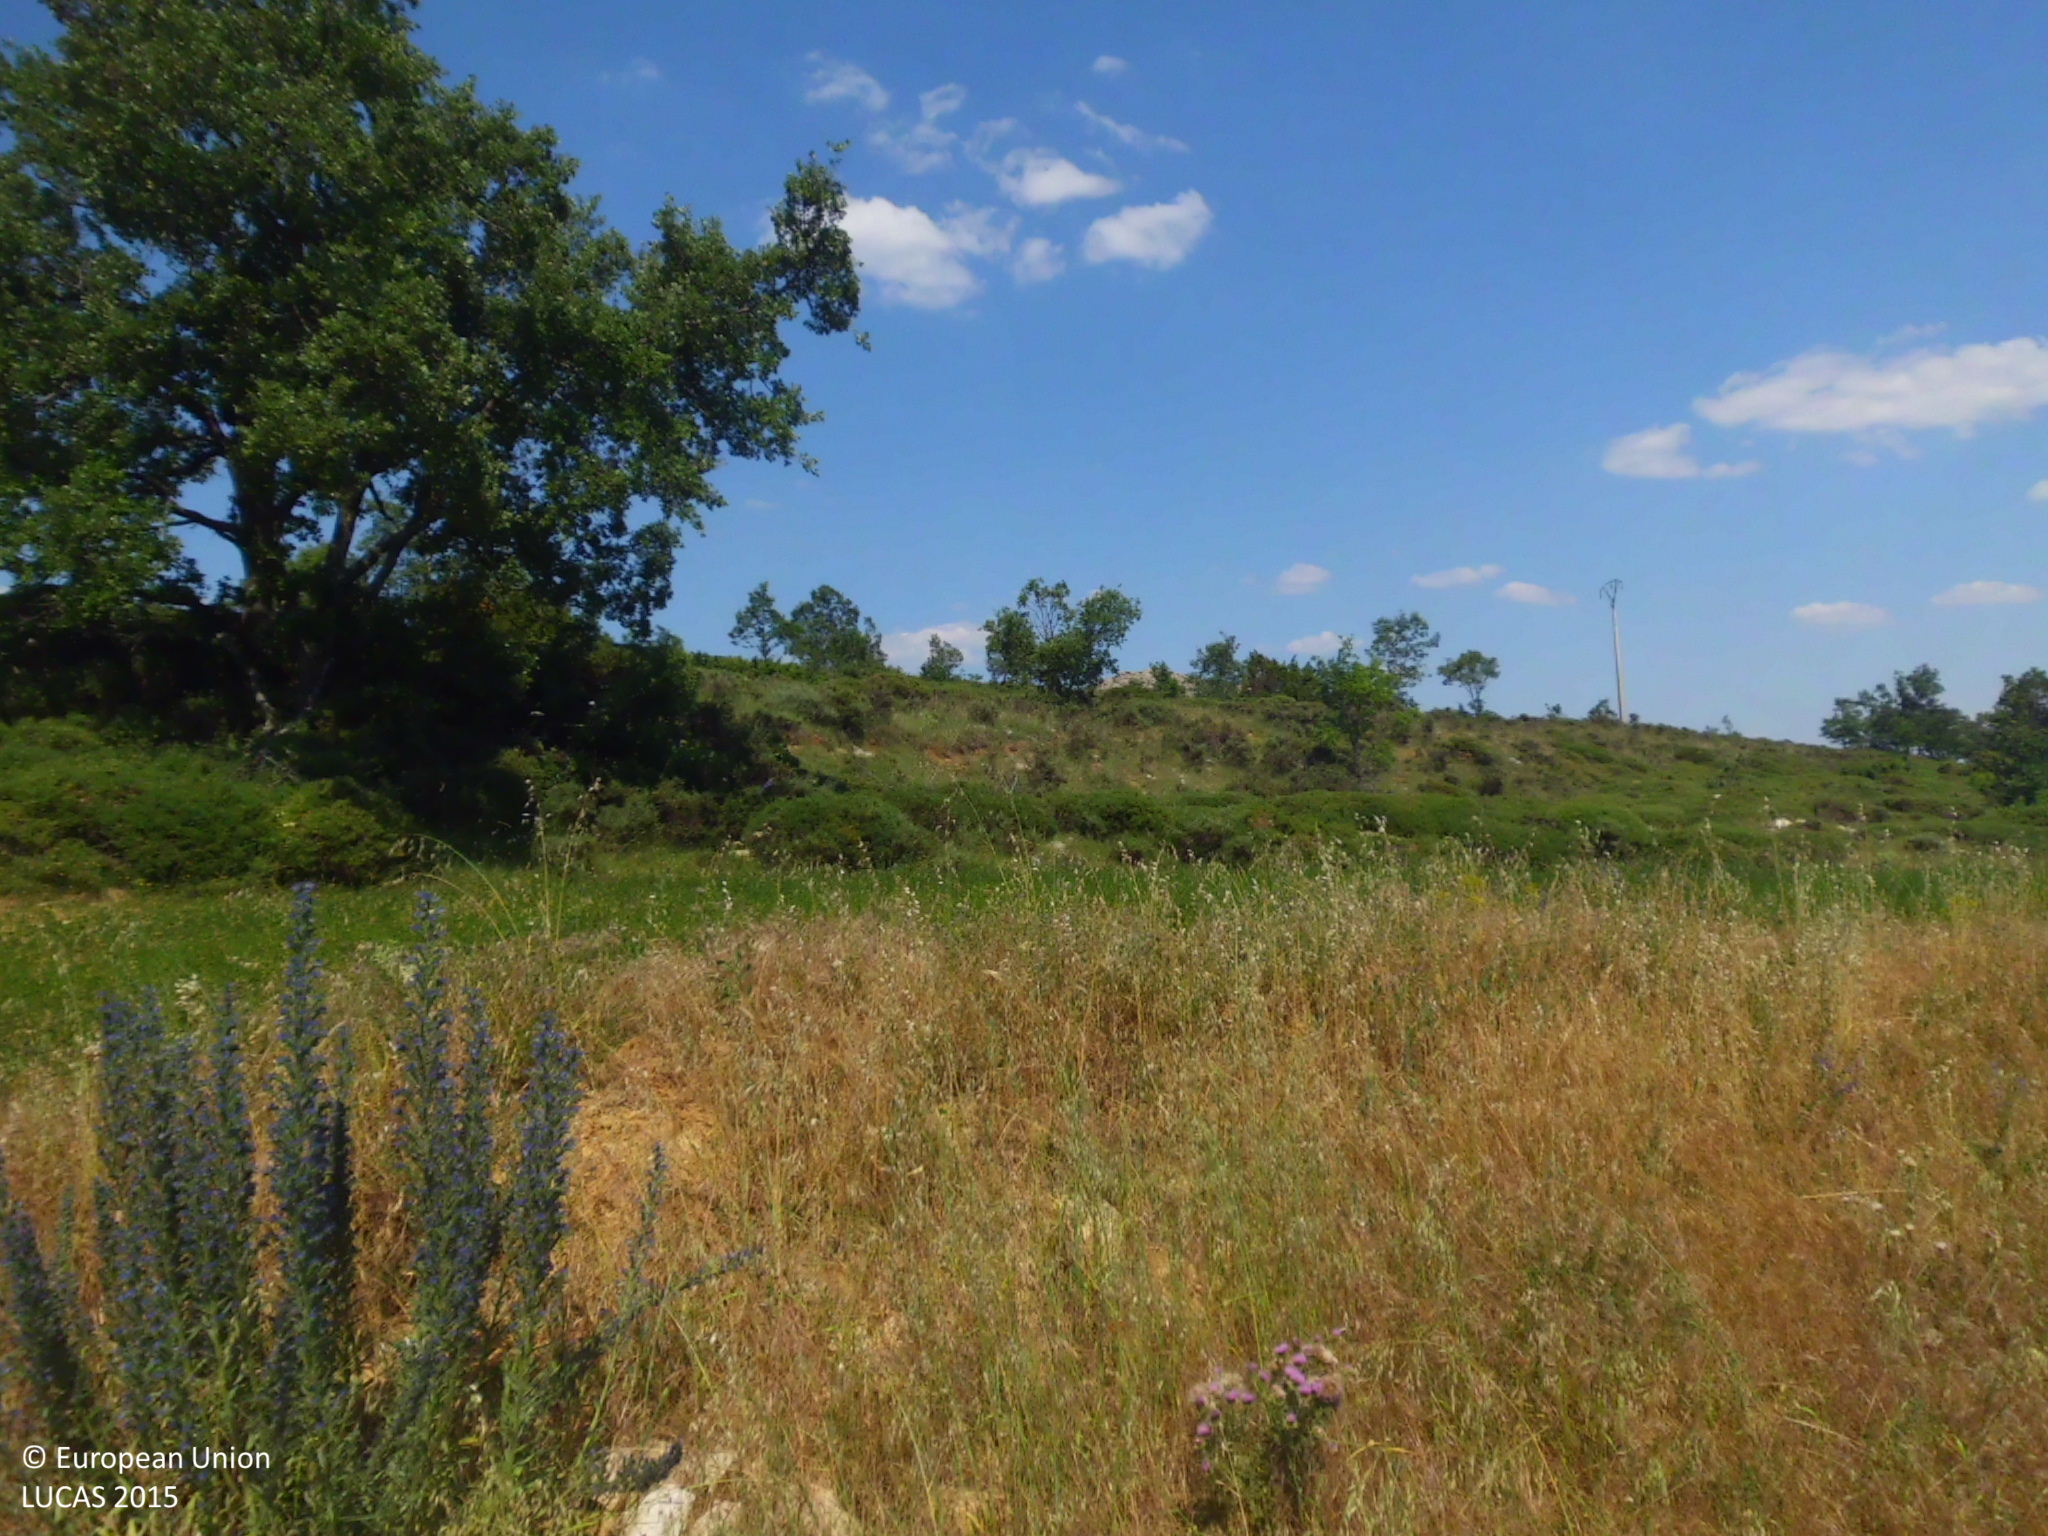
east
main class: Cropland
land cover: Lucerne
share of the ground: 50 - 75 %
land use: Agriculture (excluding fallow land and kitchen gardens)
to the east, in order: Lucerne; Grassland without tree/shrub cover; Lucerne; Shrubland with sparse tree cover; Electric lines; Shrubland with sparse tree cover; Rock outcrops; Shrubland with sparse tree cover
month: June
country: ES
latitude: 42.8204
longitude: -4.4497
